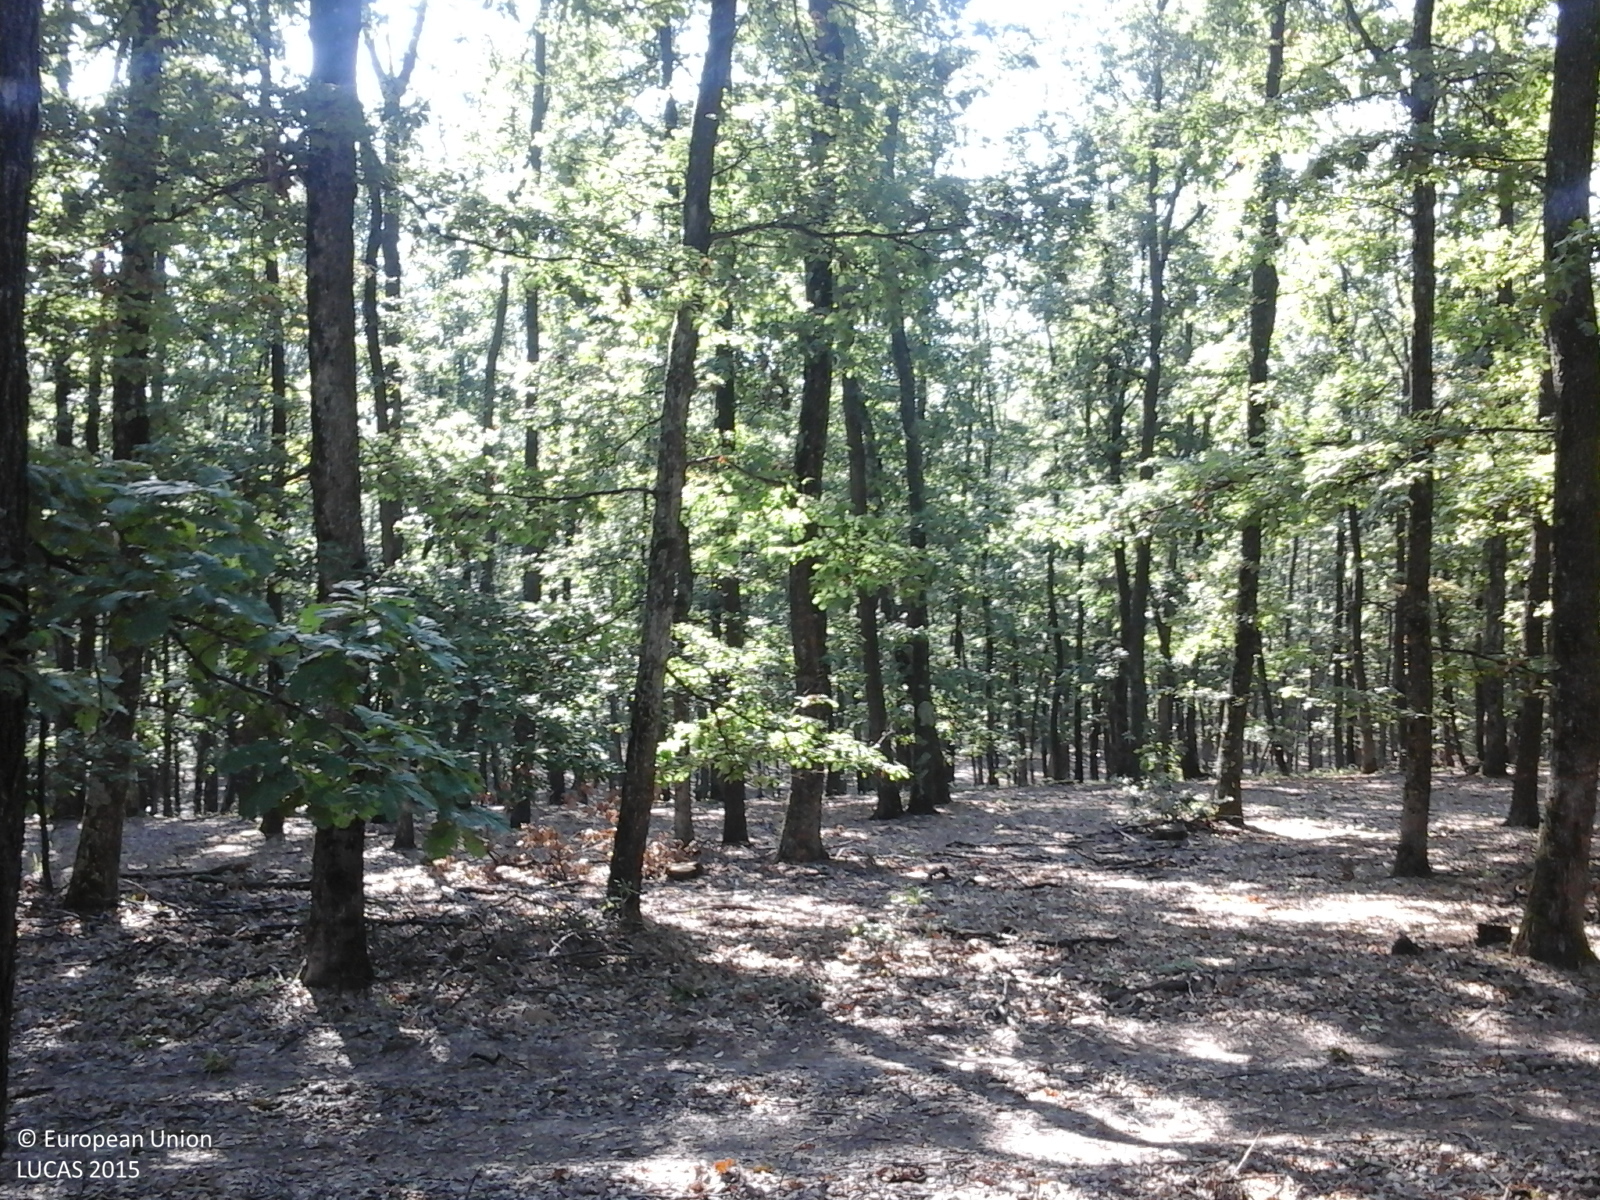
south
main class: Woodland
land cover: Broadleaved woodland
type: acidophilous oak and oak-birch forest
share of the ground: > 75 %
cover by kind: broadleaved forest trees 100 %
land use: Forestry
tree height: > 5 m
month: September
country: RO
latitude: 47.4138
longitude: 22.6902
